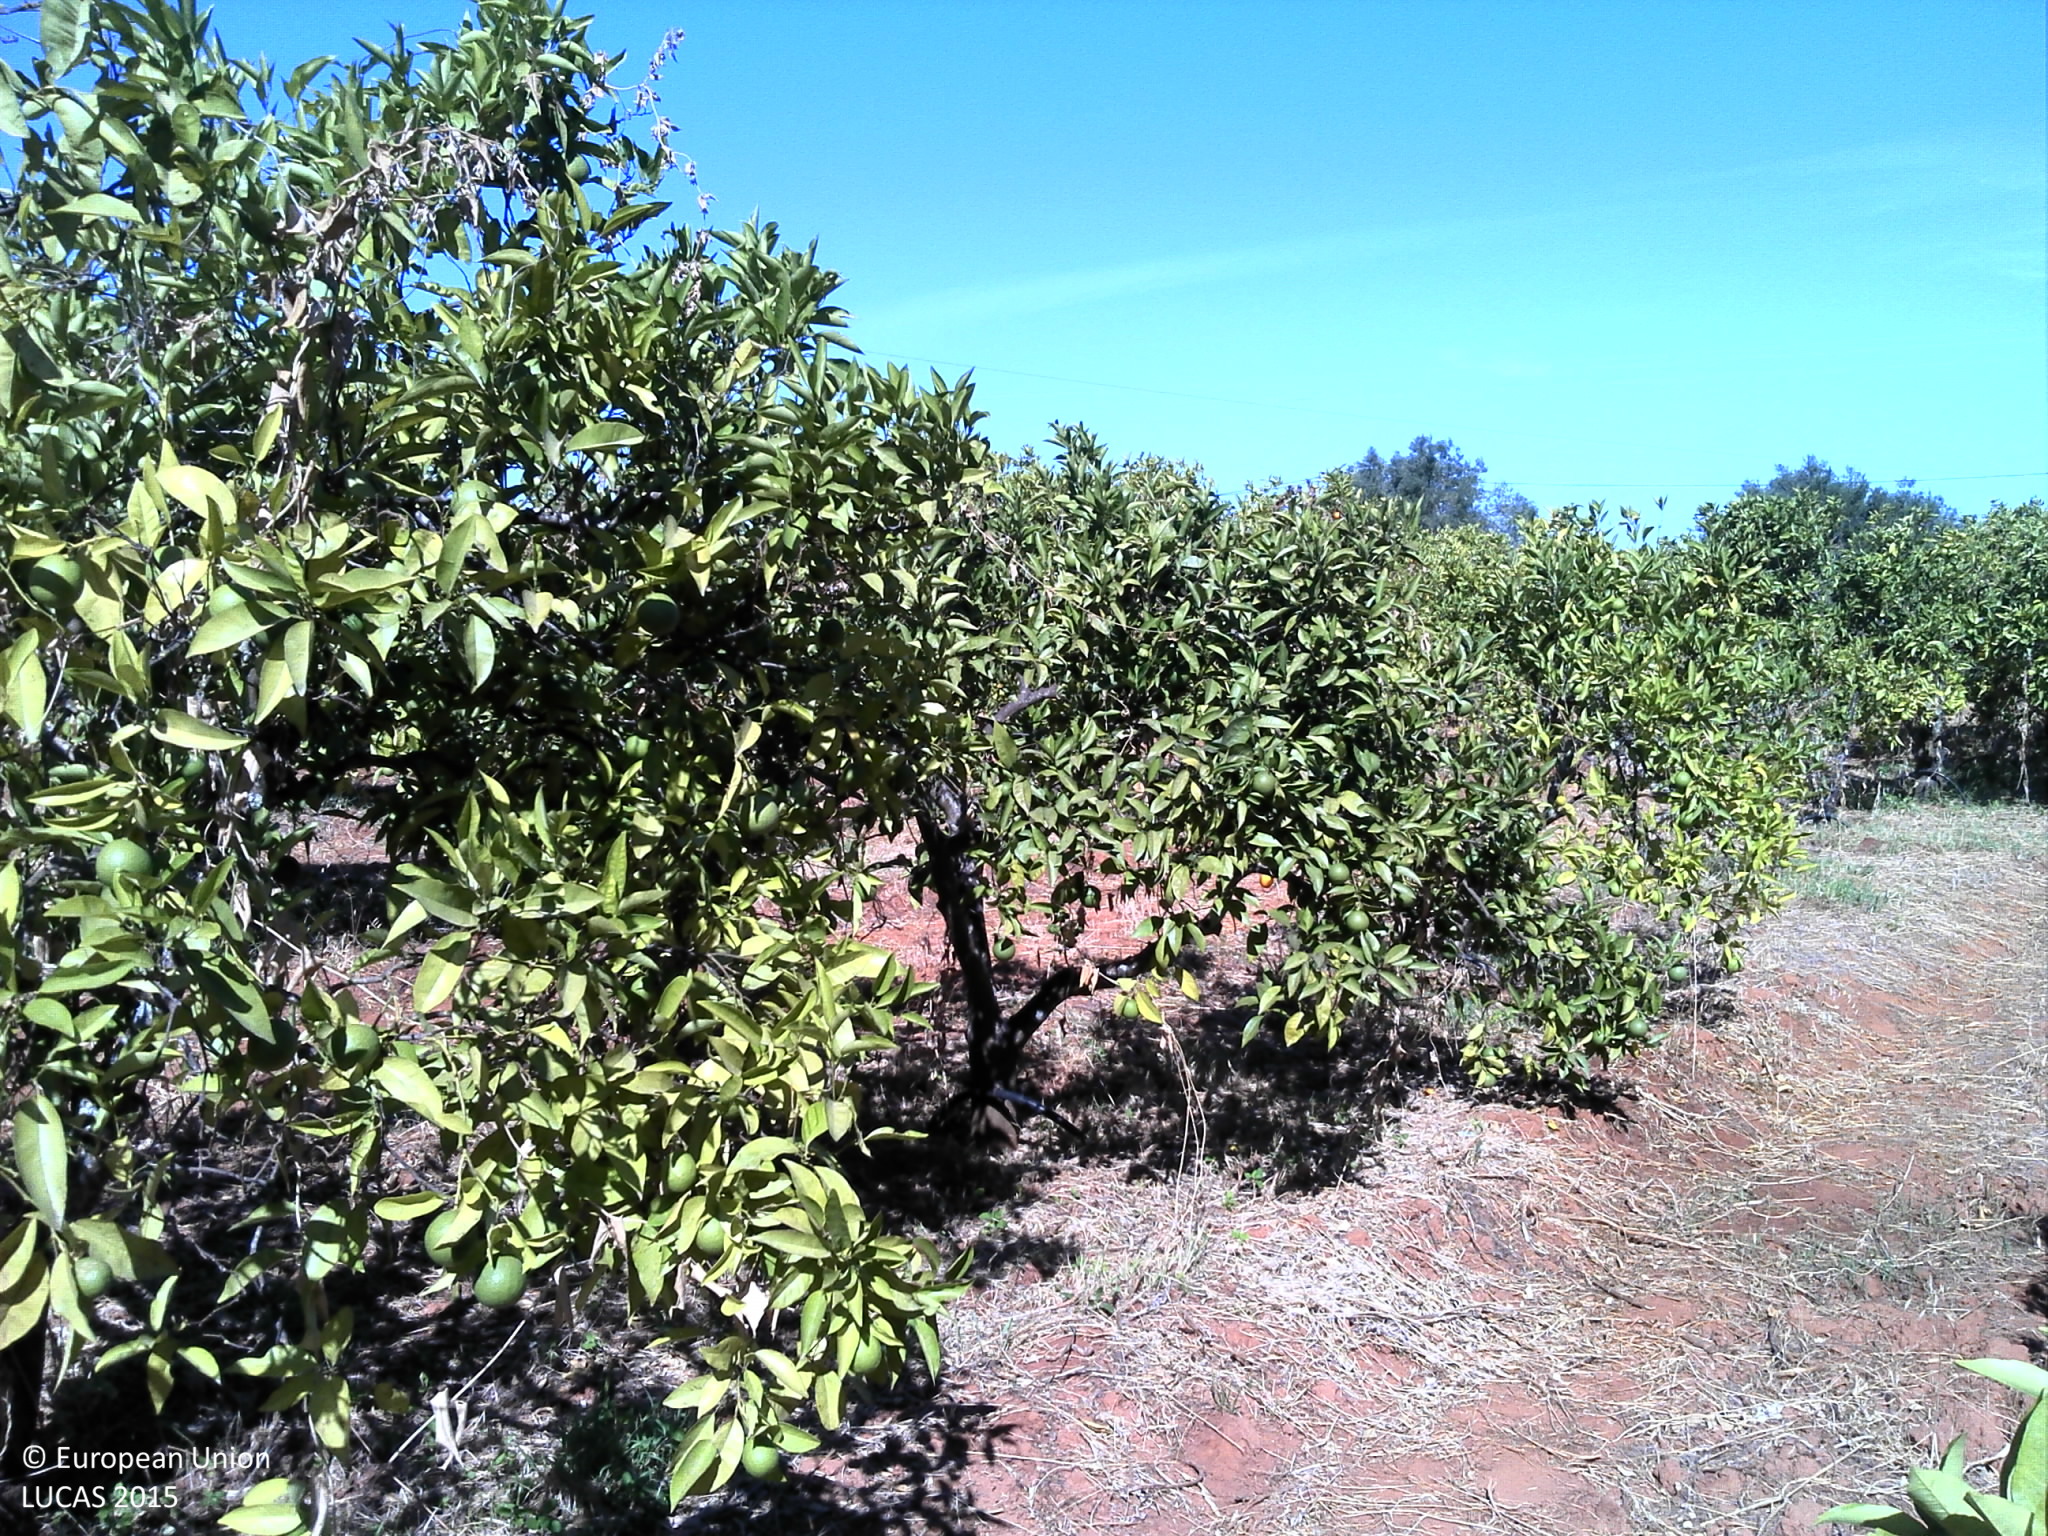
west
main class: Cropland
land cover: Oranges
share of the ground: 50 - 75 %
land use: Agriculture (excluding fallow land and kitchen gardens)
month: September
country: PT
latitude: 37.1115
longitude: -8.1679
